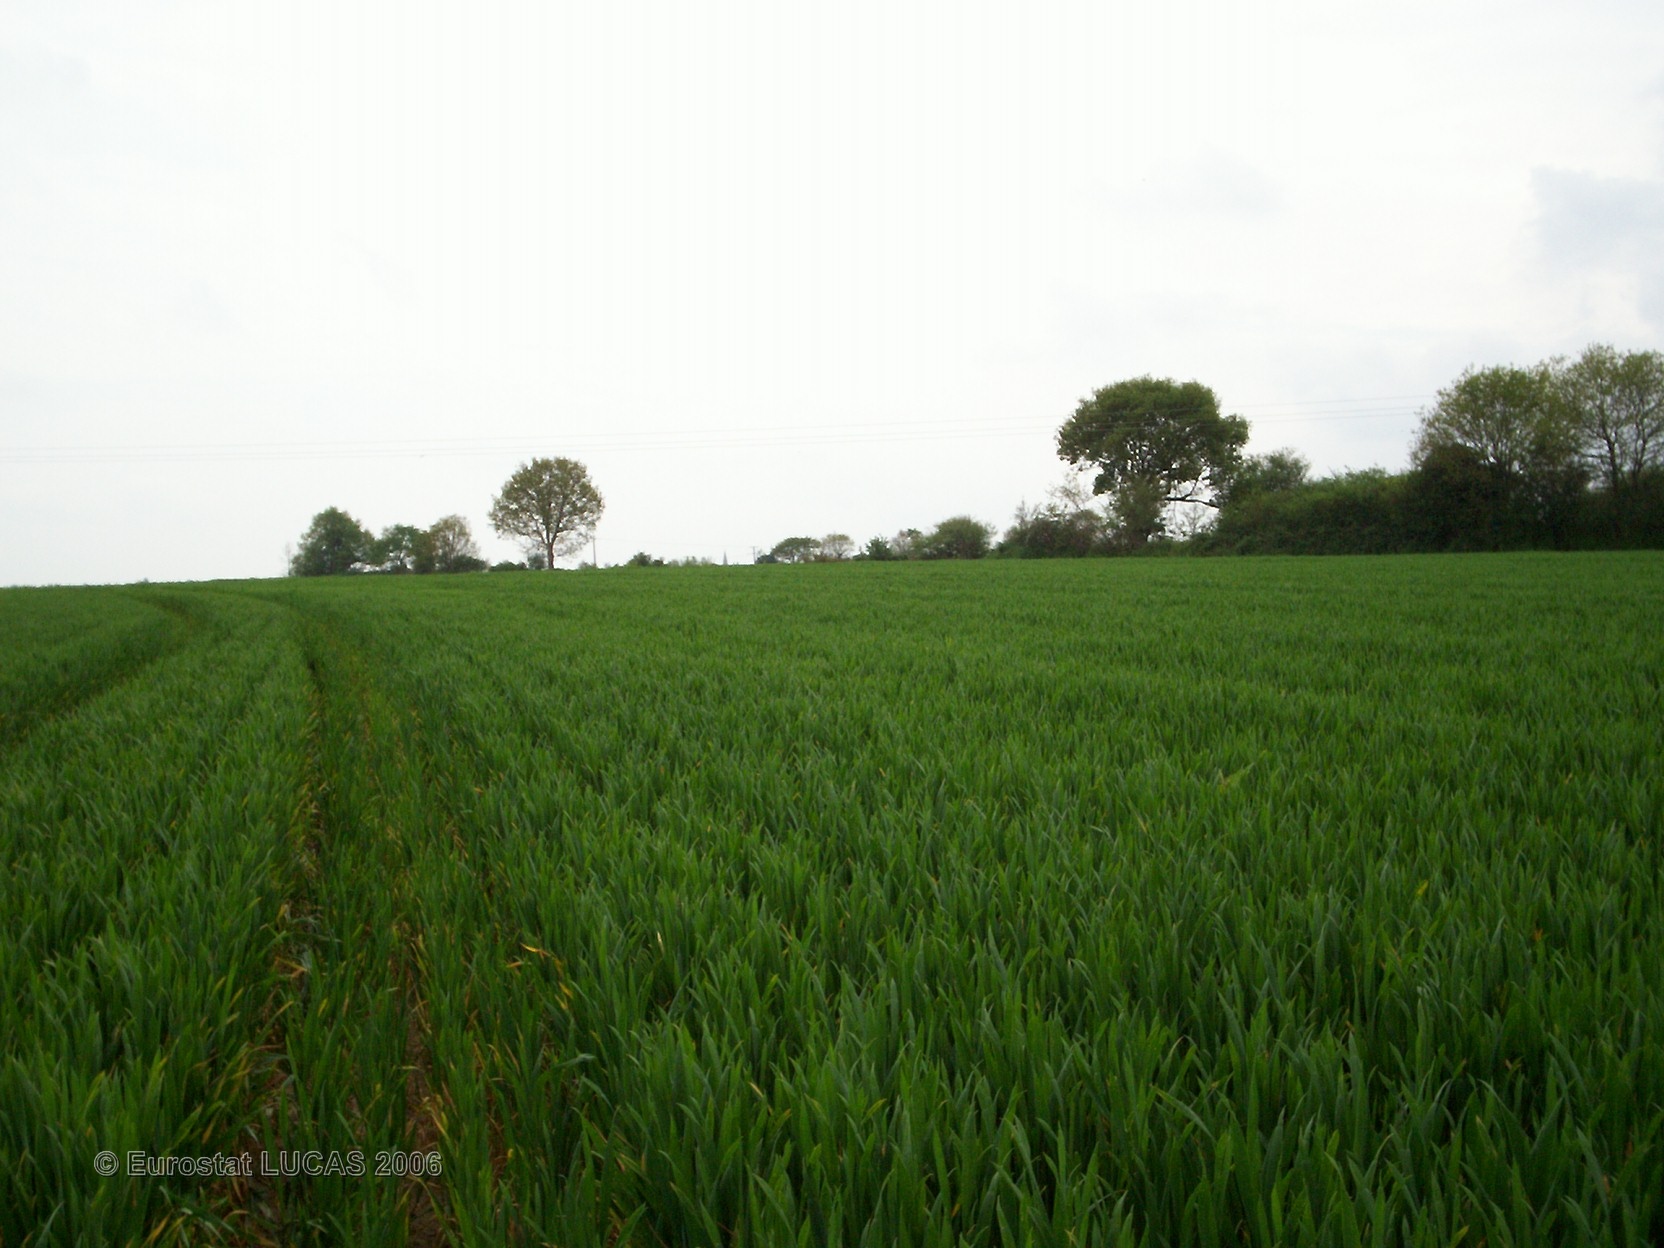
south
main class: Cropland
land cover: Common wheat
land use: Agriculture (excluding fallow land and kitchen gardens)
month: May
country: FR
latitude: 48.6983
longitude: -3.0746
